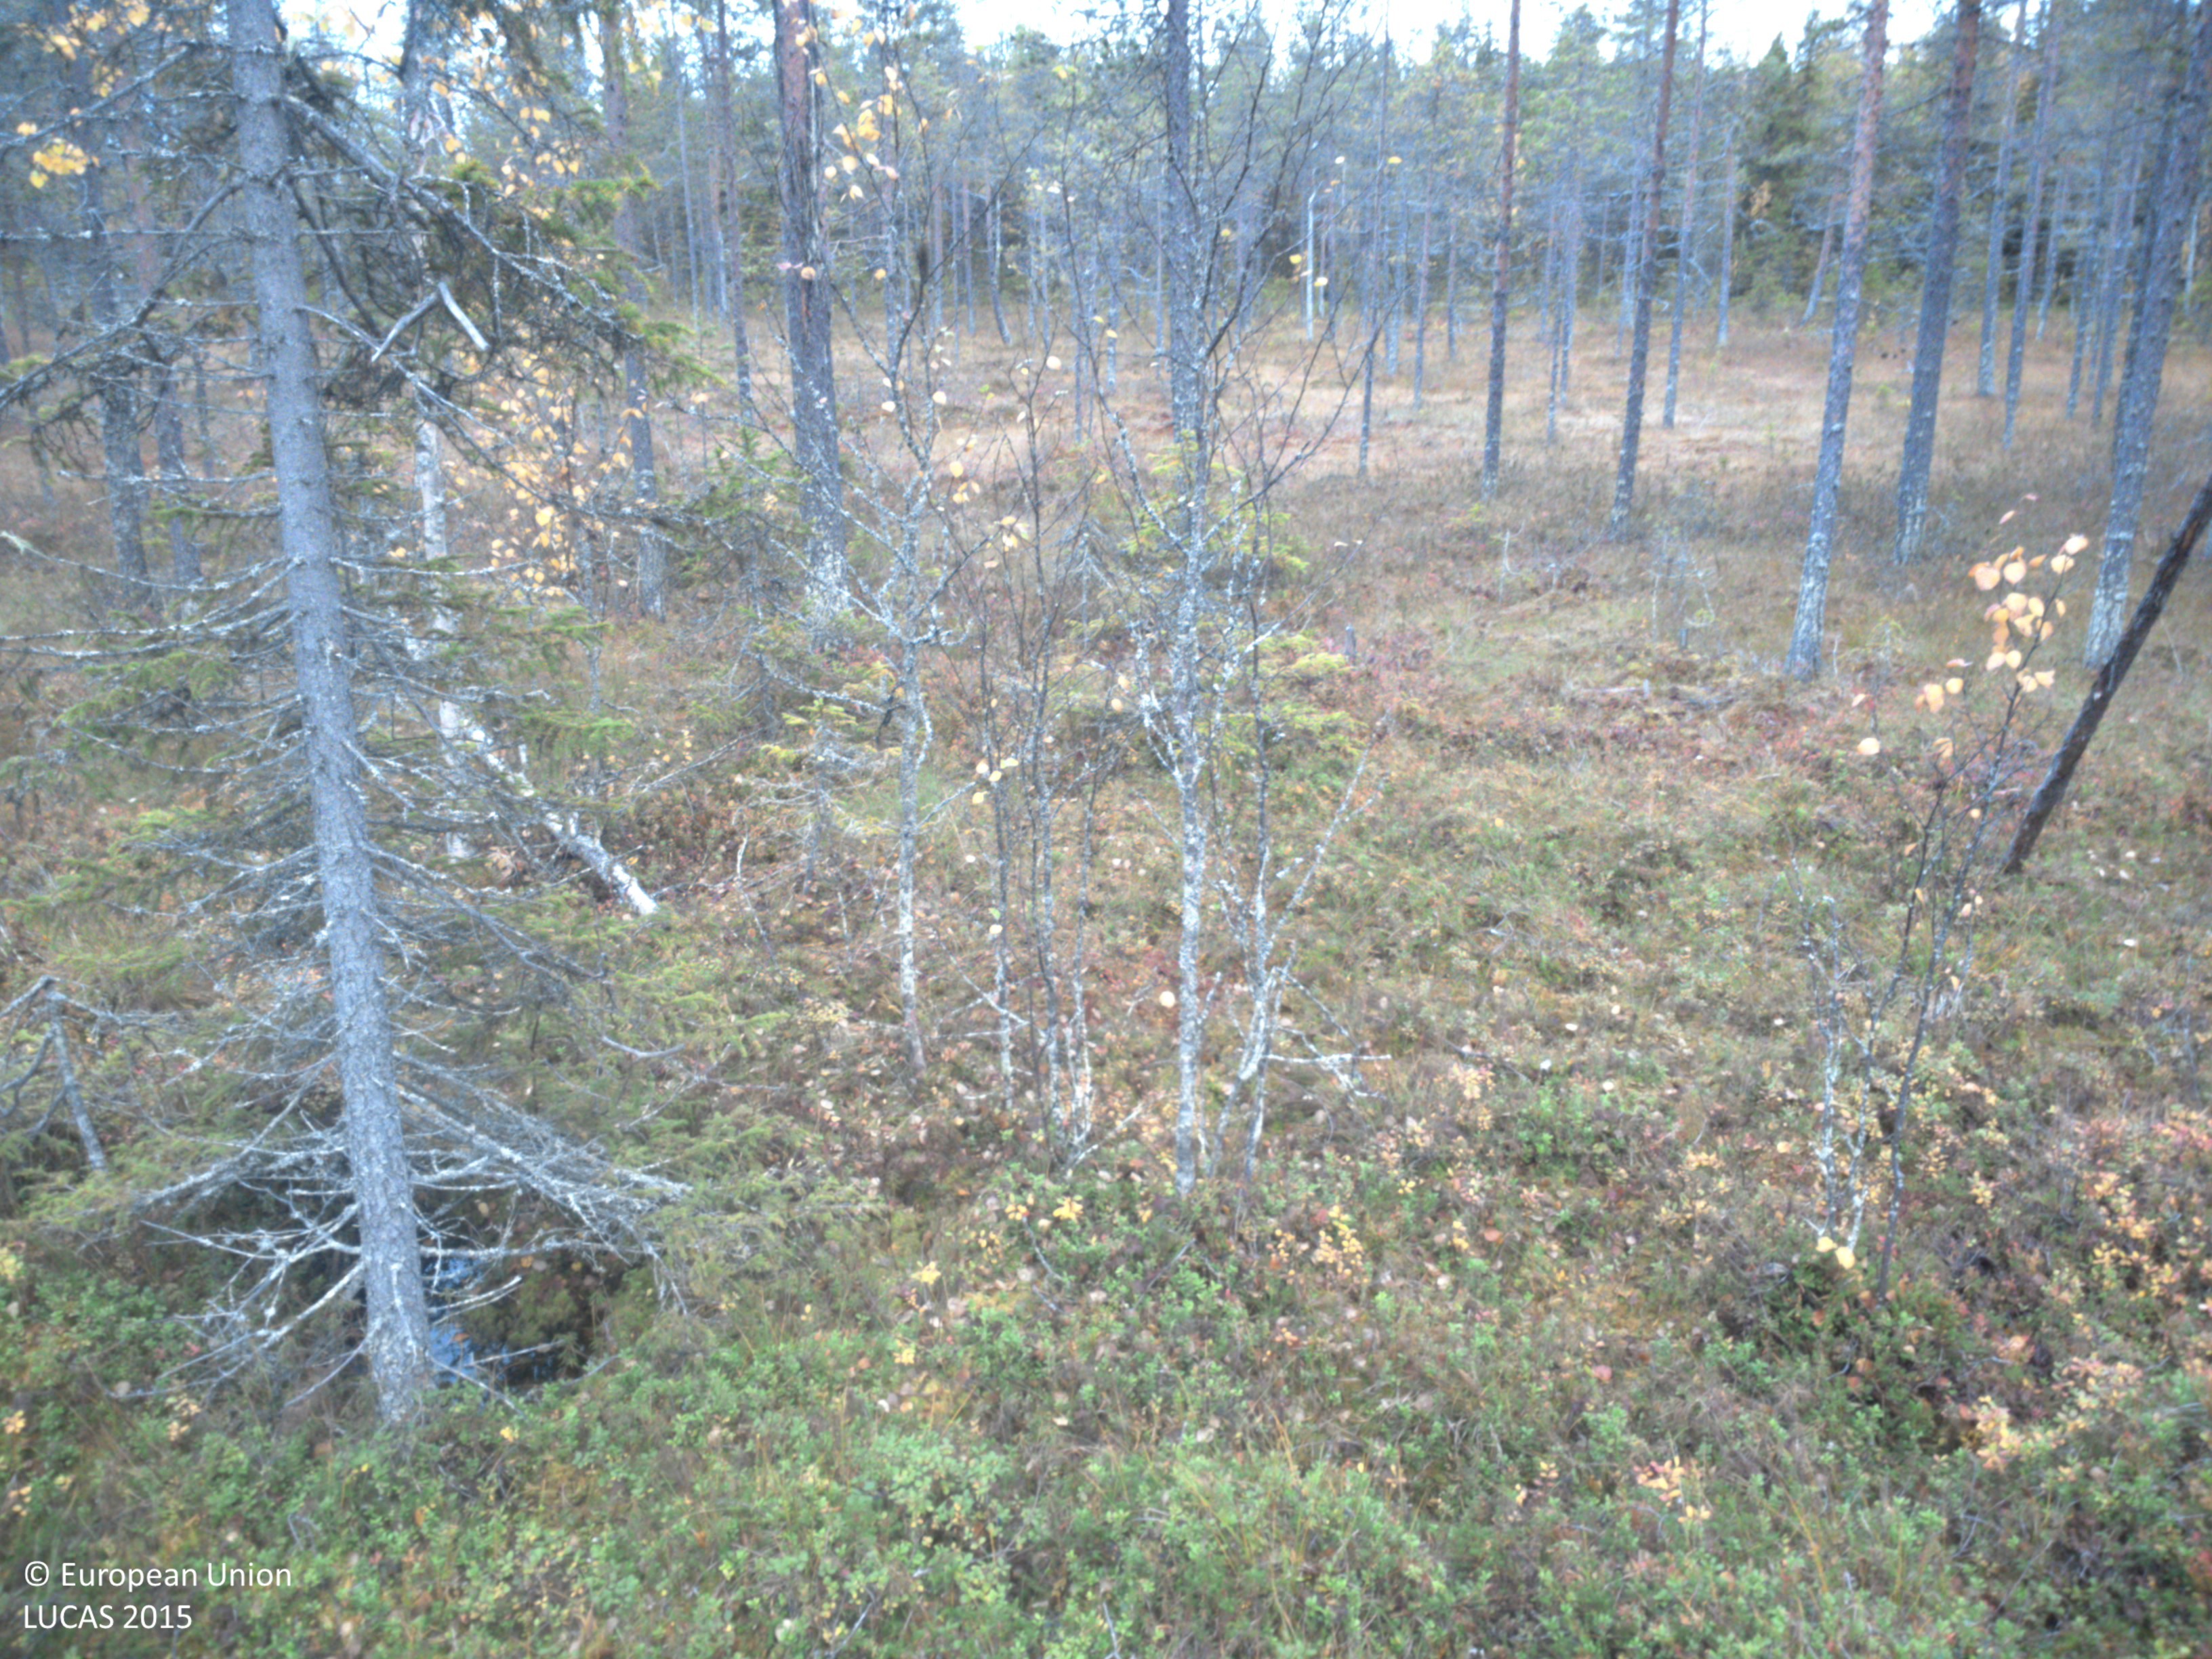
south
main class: Shrubland
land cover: Shrubland with sparse tree cover
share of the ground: > 75 %
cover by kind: shrubs 95 %, coniferous forest trees 5 %
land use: Forestry
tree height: < 5 m
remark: Clear cut
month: September
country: SE
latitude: 64.7670
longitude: 19.8309
